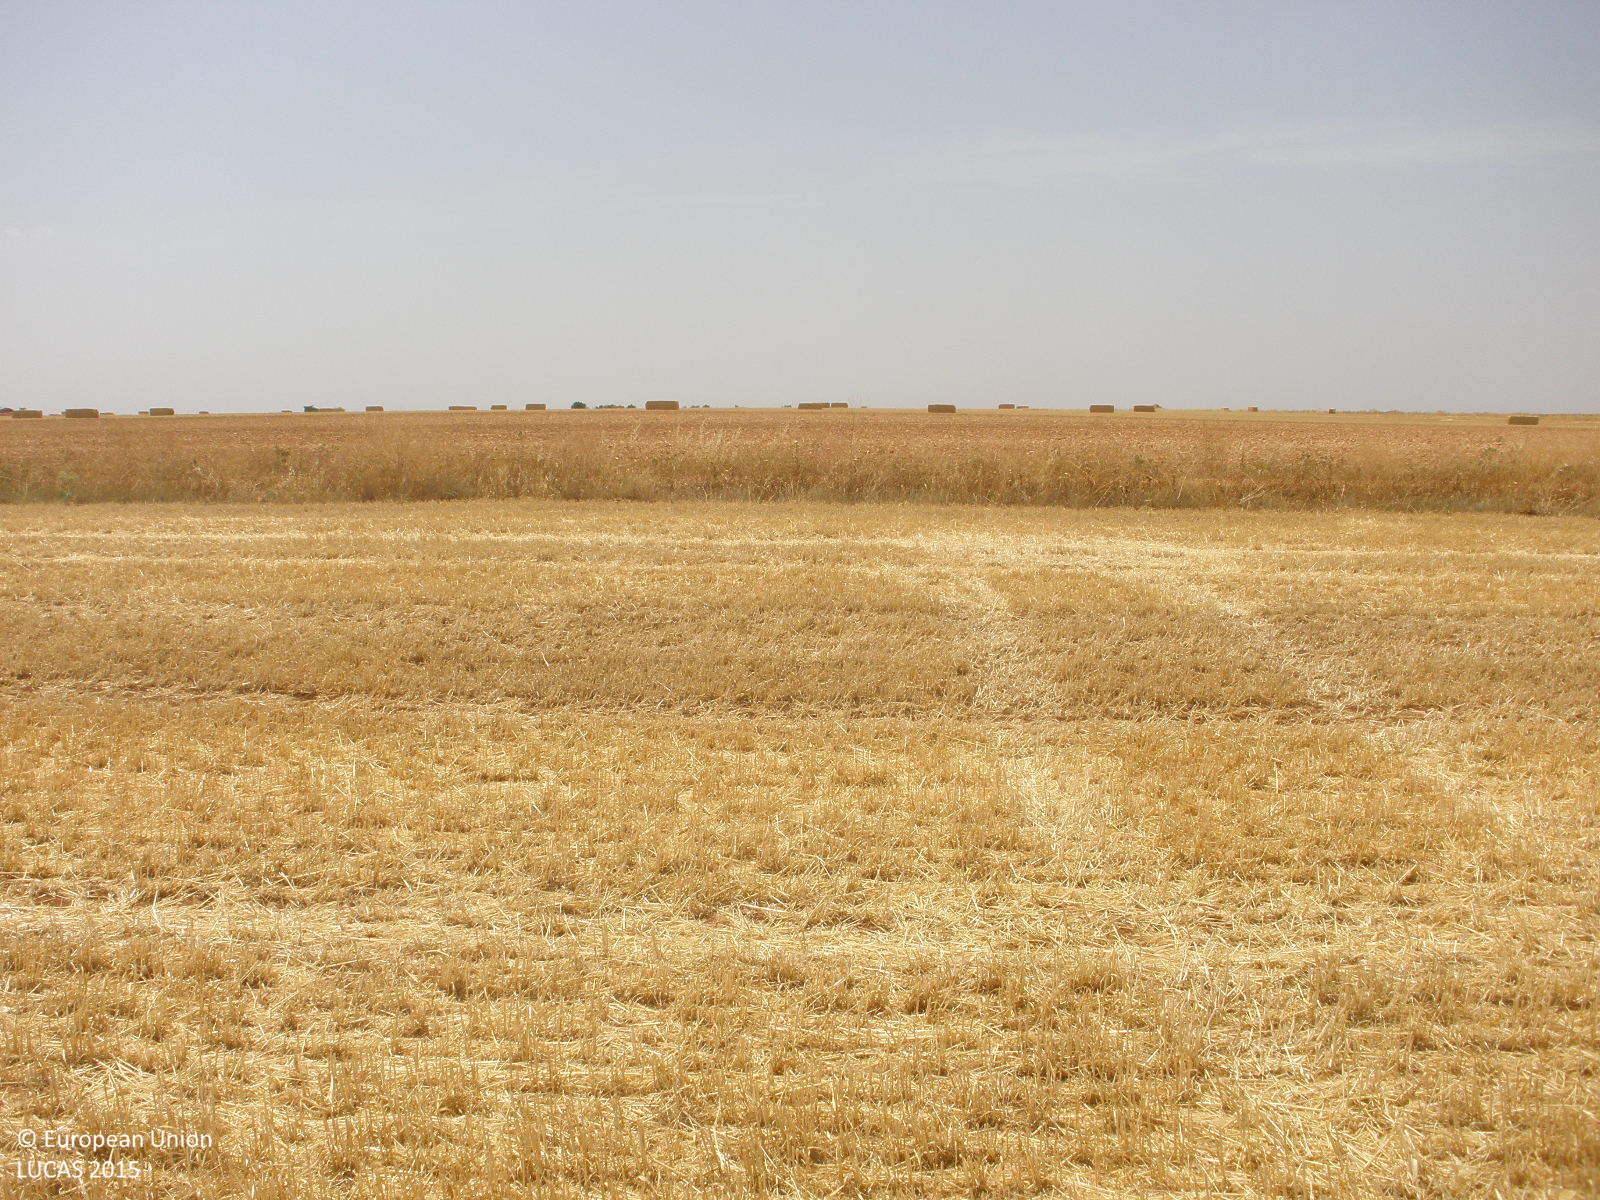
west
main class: Cropland
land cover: Barley
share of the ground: < 10 %
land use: Agriculture (excluding fallow land and kitchen gardens)
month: July
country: ES
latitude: 39.8969
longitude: -3.3713
